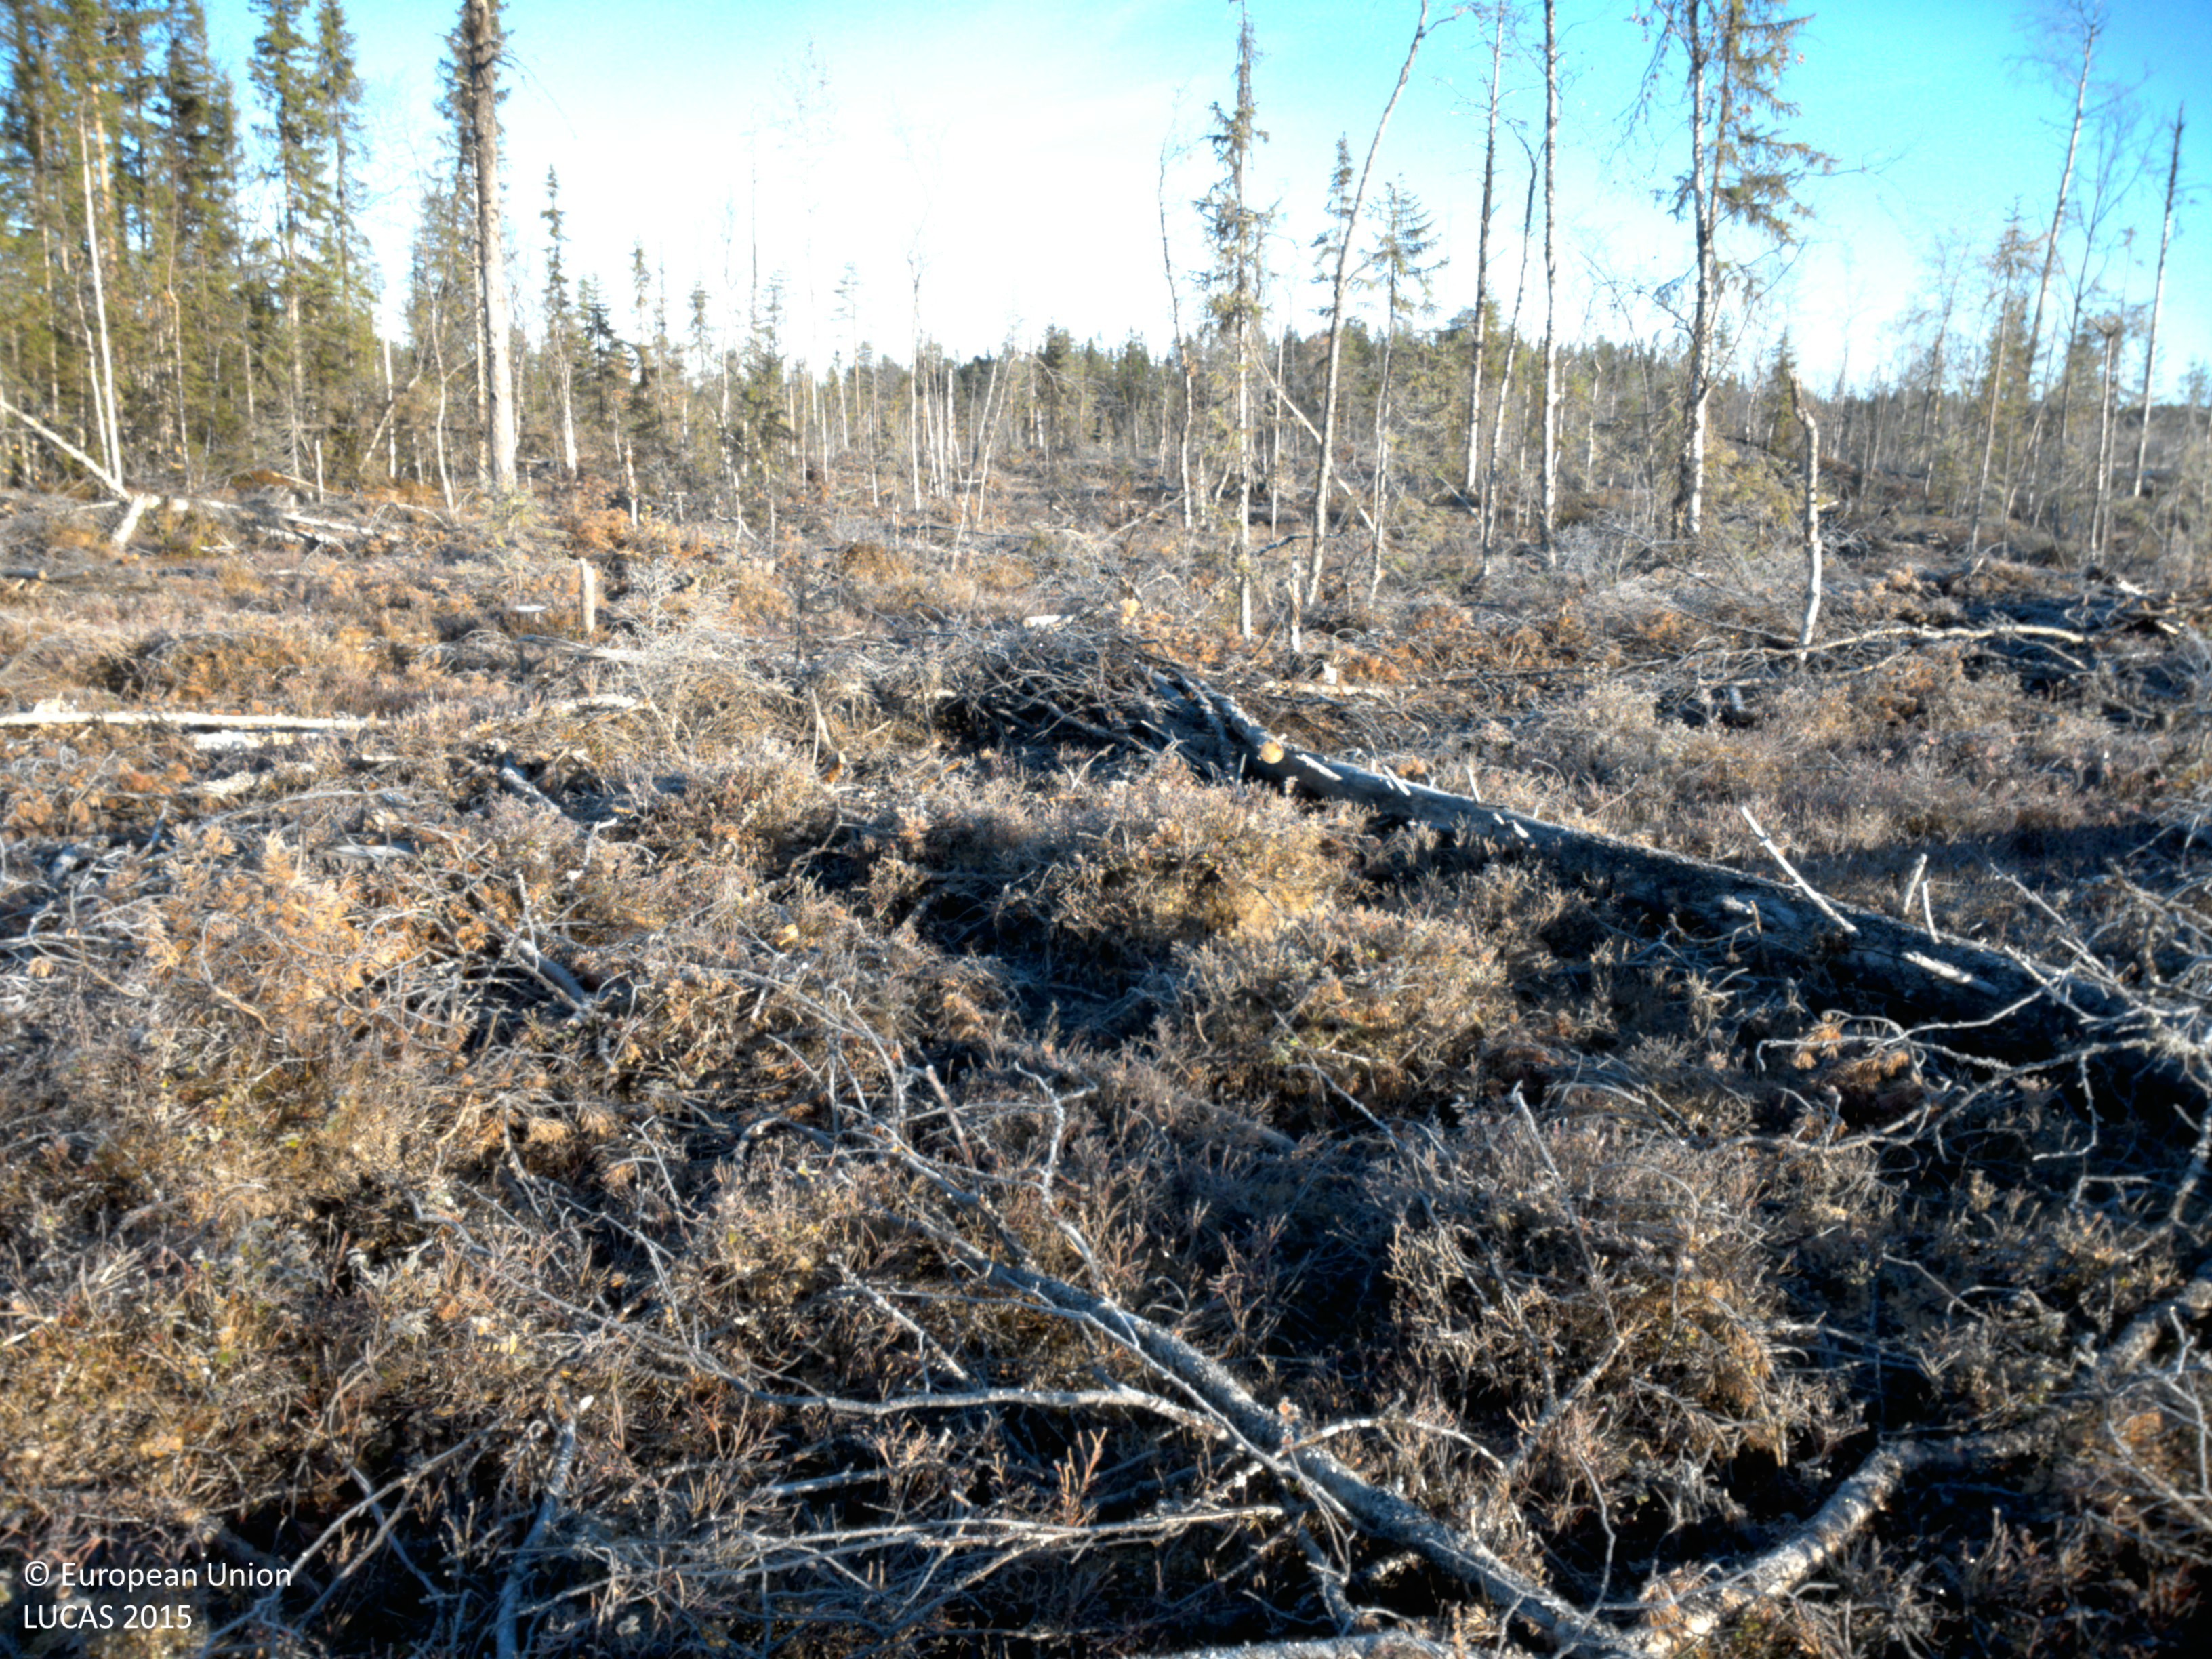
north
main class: Shrubland
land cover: Shrubland with sparse tree cover
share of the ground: 10 - 25 %
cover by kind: shrubs 10 %, coniferous forest trees 5 %
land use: Forestry
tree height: < 5 m
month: October
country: SE
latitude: 64.7331
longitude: 17.7976
